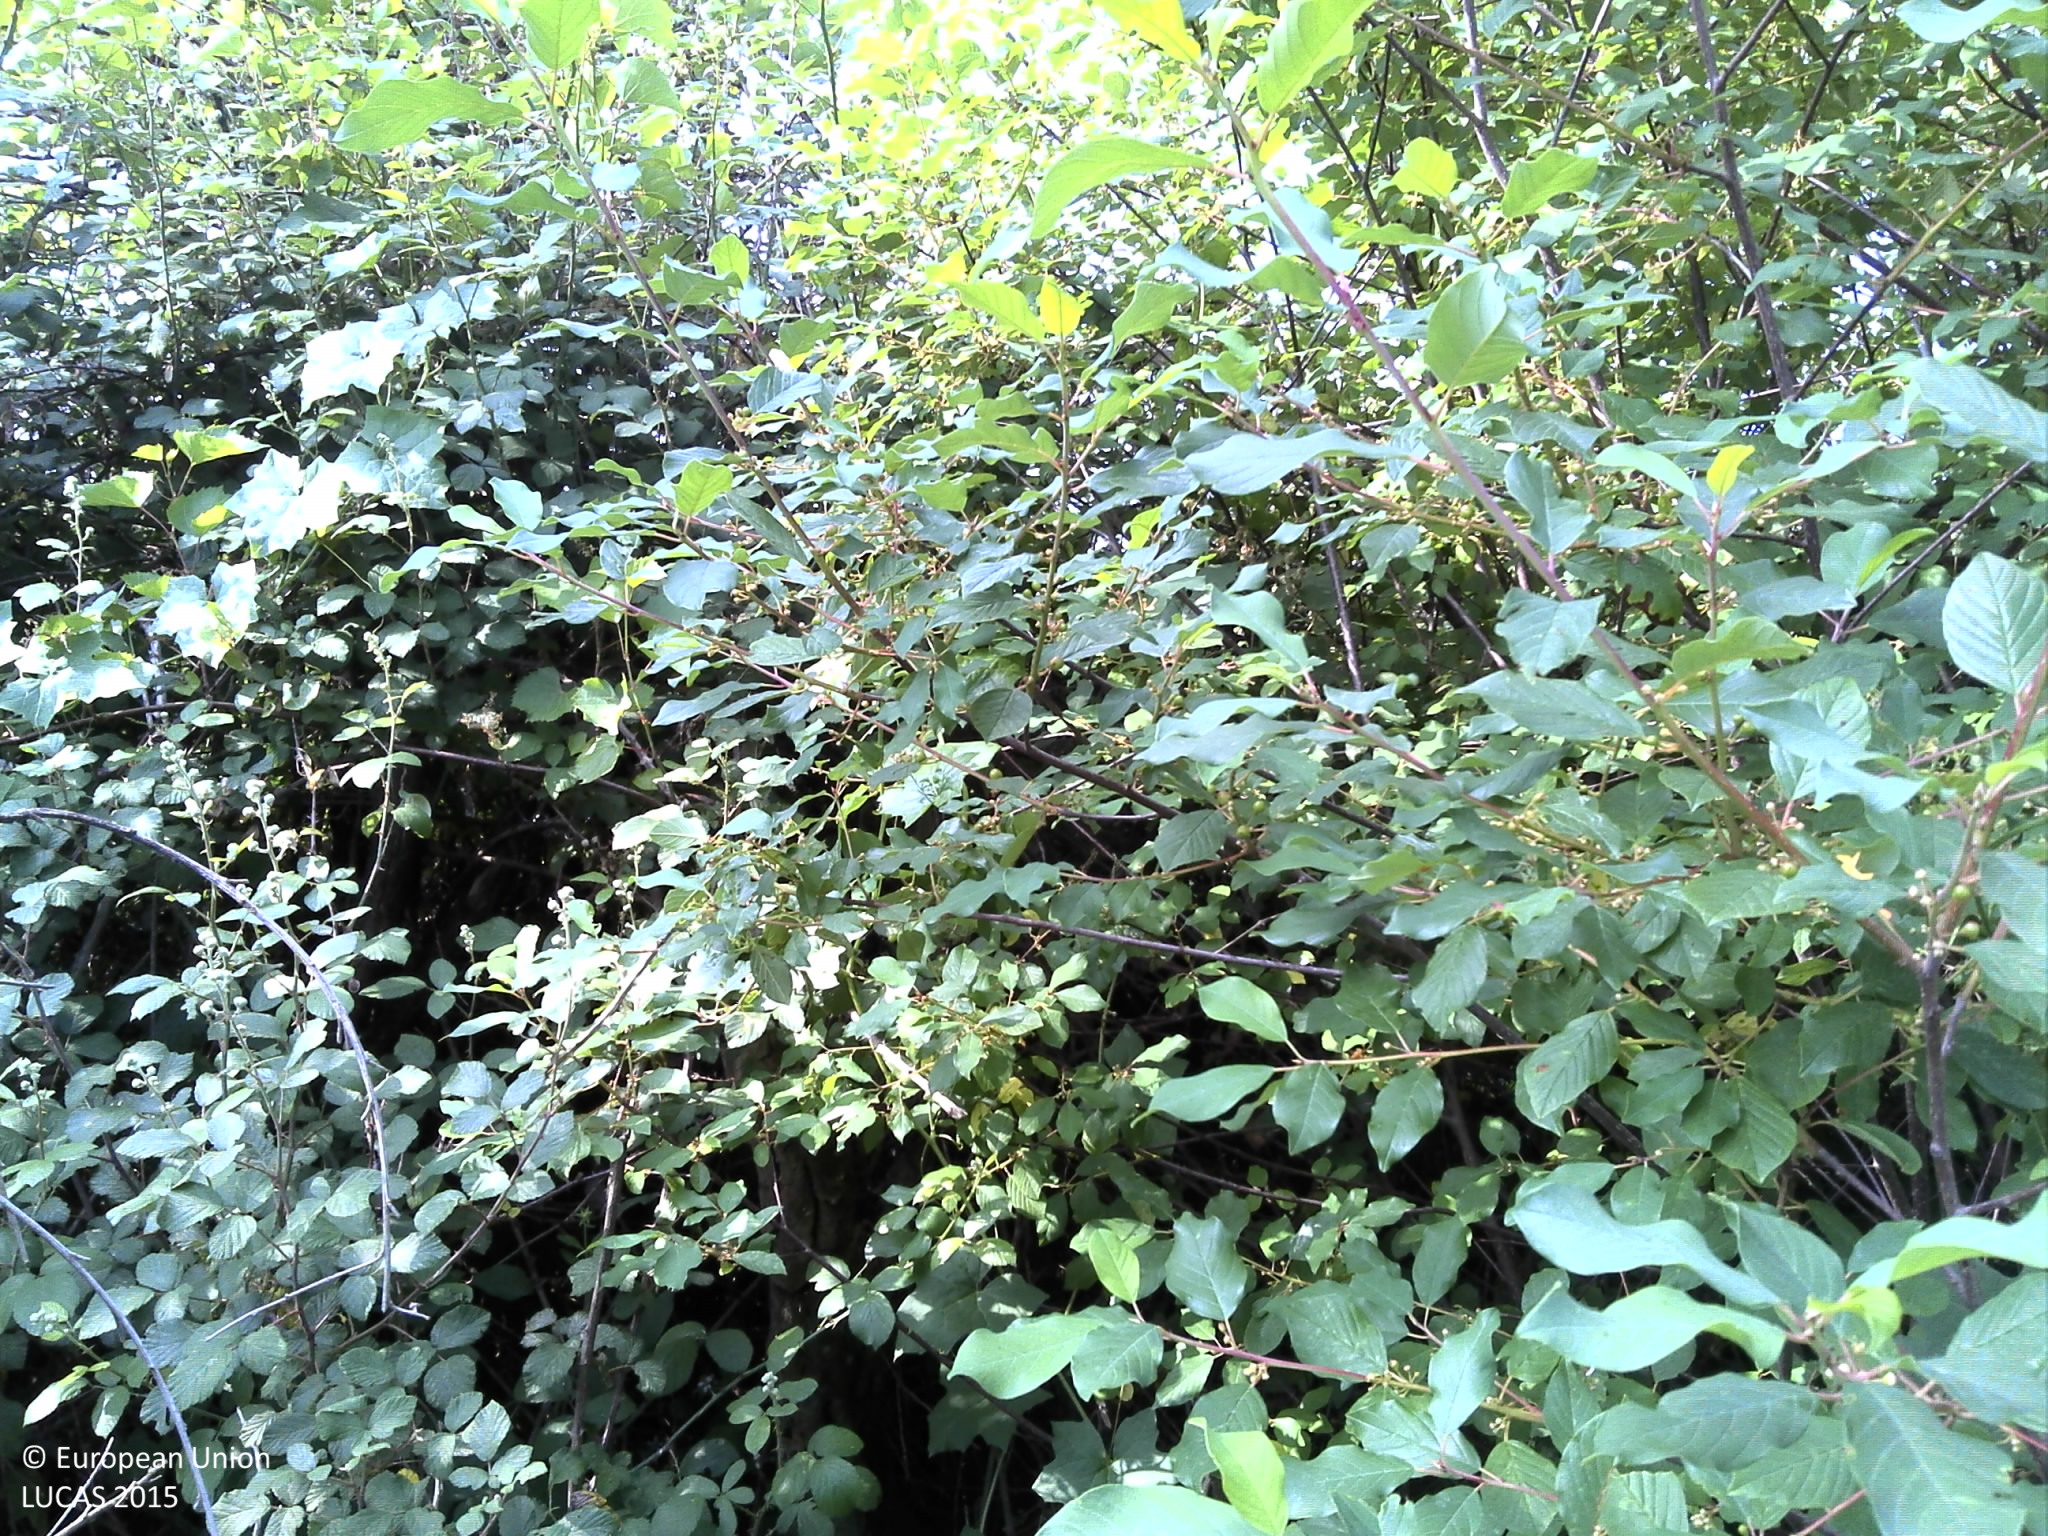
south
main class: Shrubland
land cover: Shrubland with sparse tree cover
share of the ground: > 75 %
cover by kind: shrubs 95 %, broadleaved forest trees 5 %
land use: Semi-natural and natural areas not in use
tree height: < 5 m
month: June
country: PT
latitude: 41.3190
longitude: -7.6045
